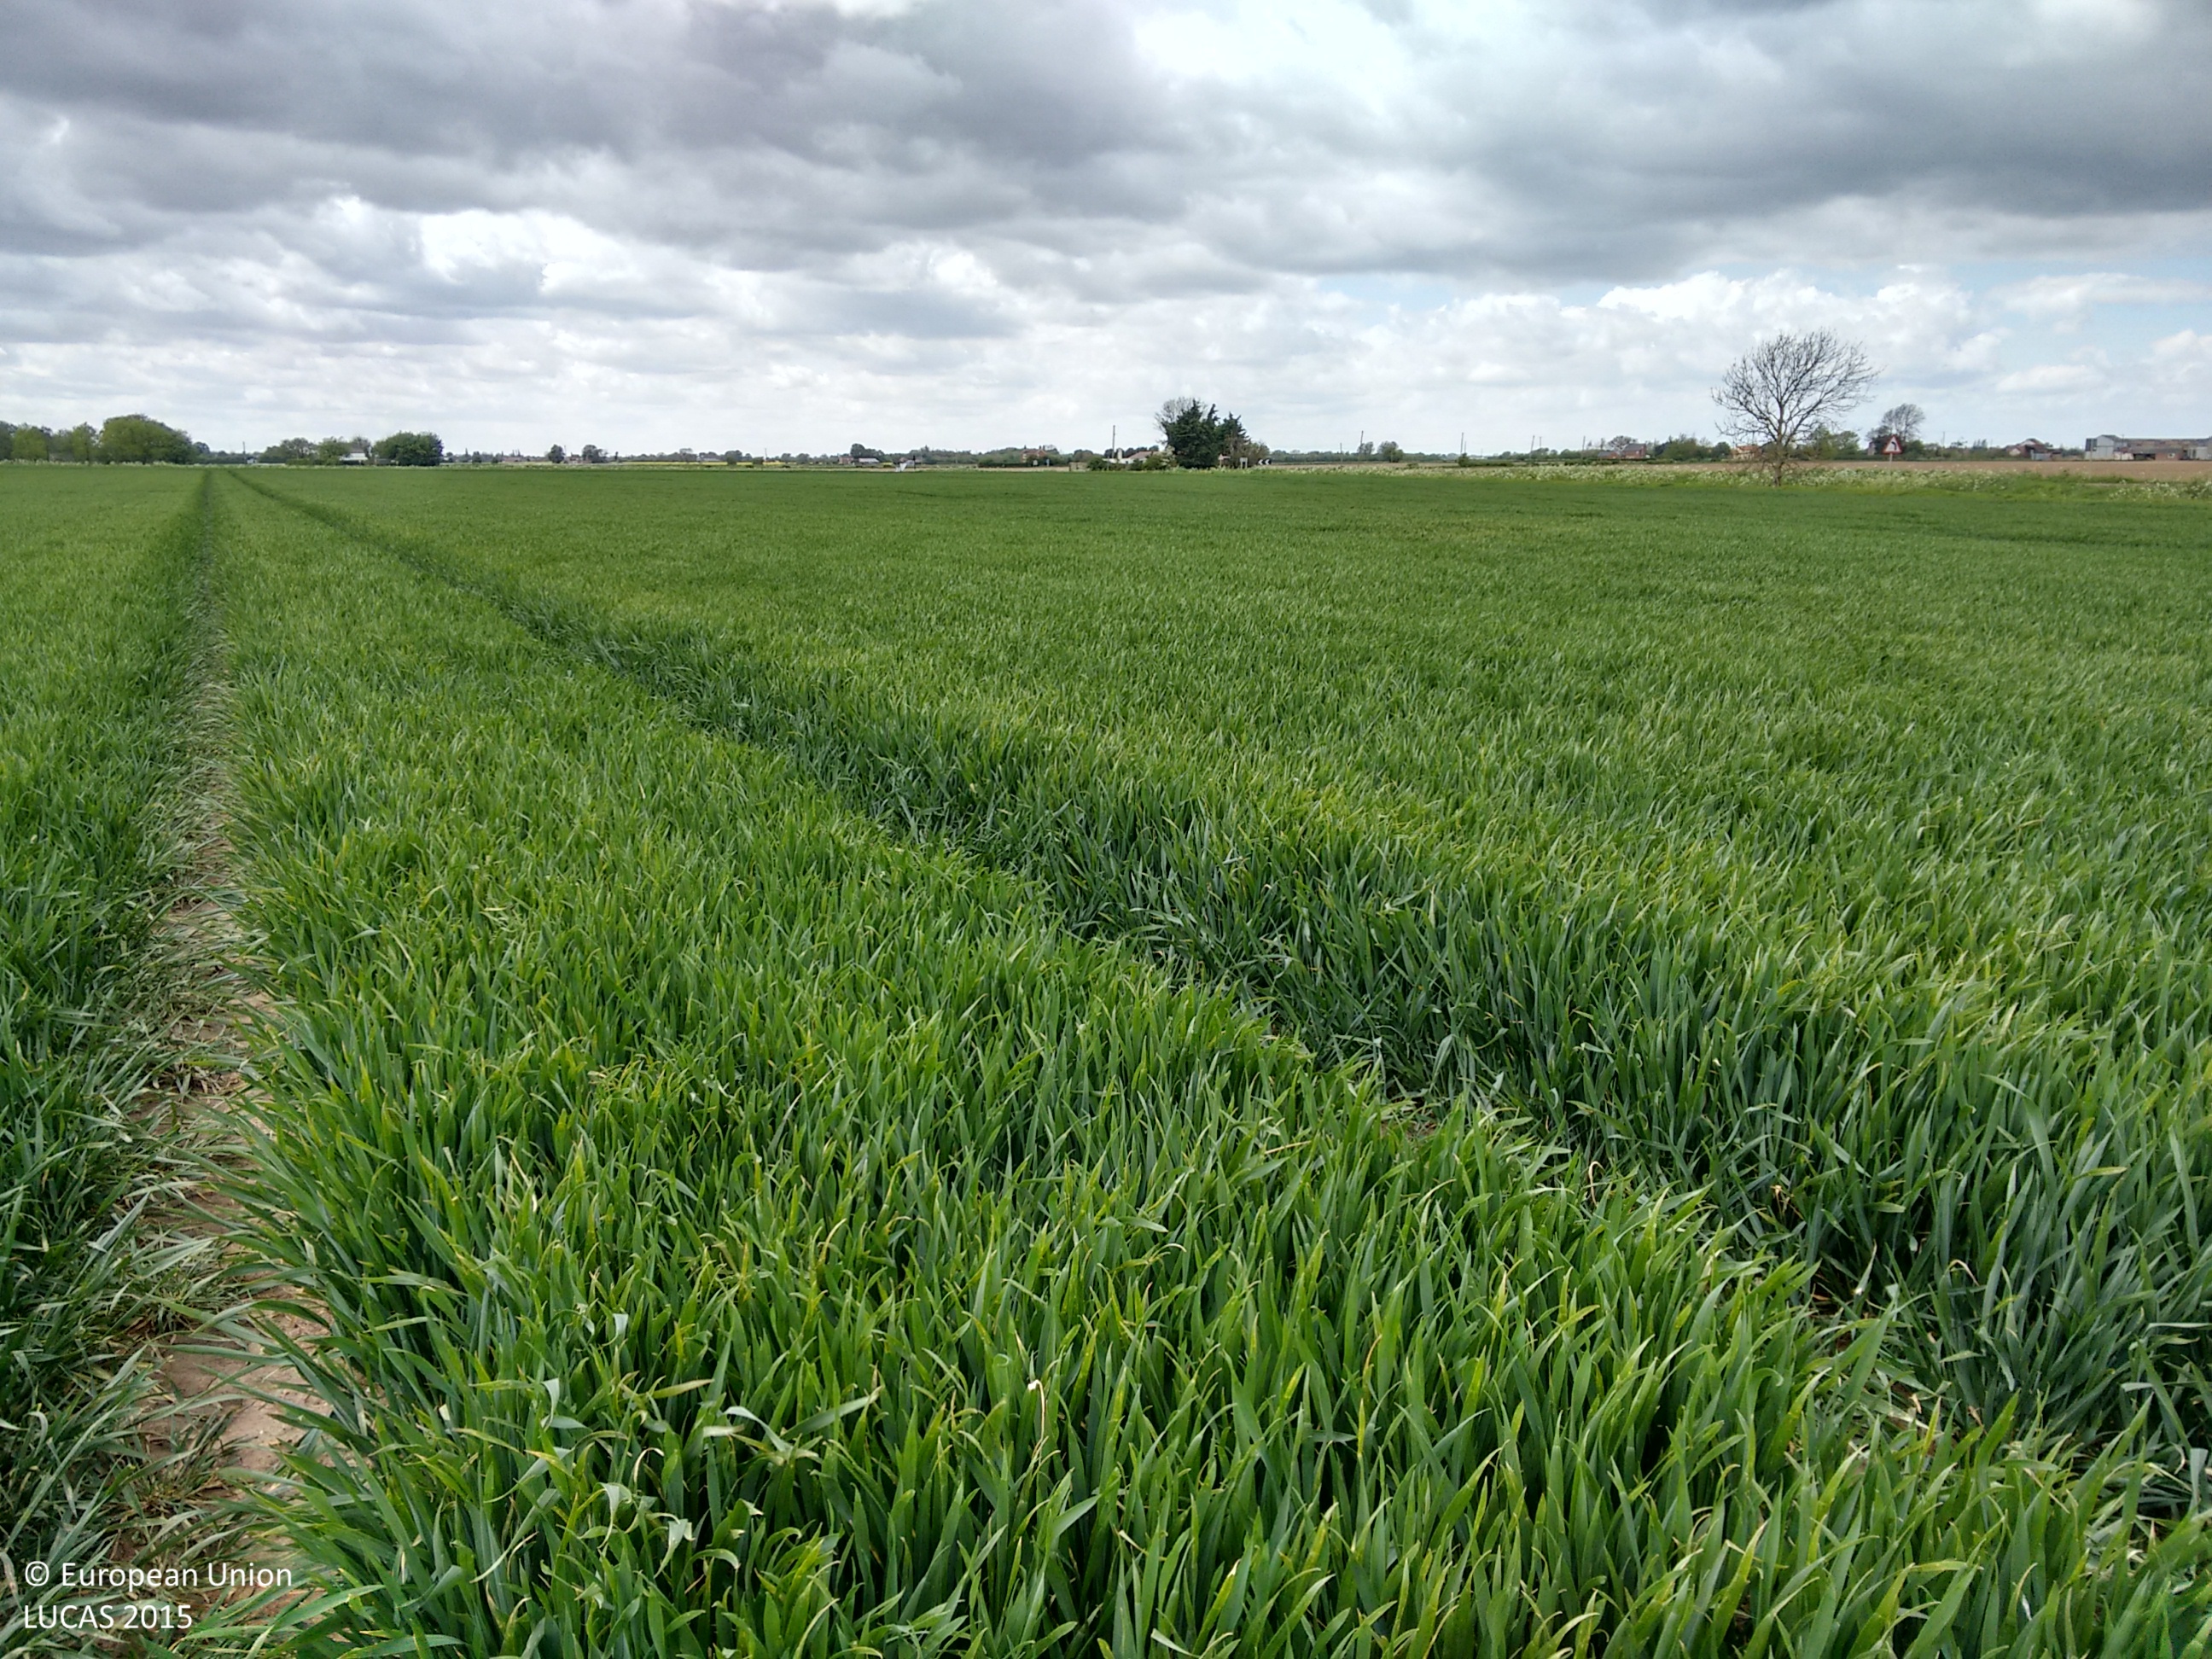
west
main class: Cropland
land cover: Barley
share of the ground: > 75 %
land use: Agriculture (excluding fallow land and kitchen gardens)
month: May
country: GB
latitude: 53.0552
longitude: 0.1674
